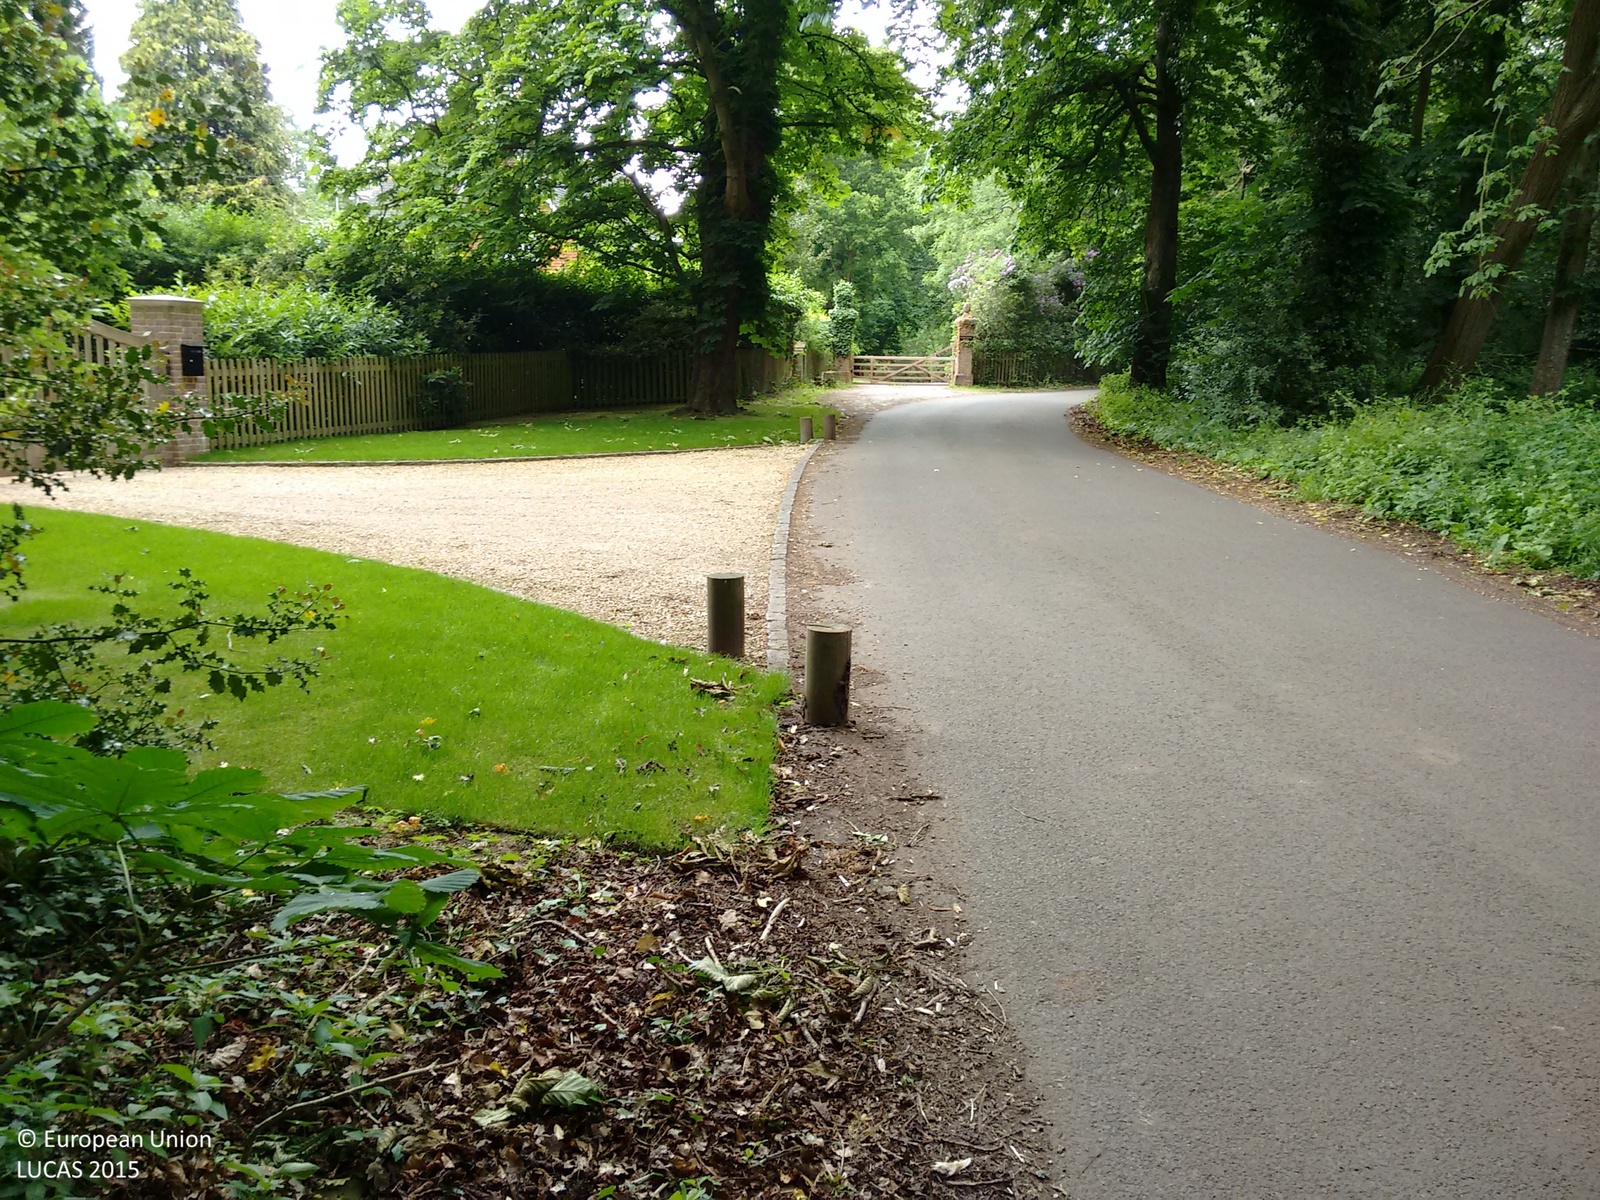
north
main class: Woodland
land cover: Broadleaved woodland
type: mesophytic deciduous forest
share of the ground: > 75 %
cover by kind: broadleaved forest trees 80 %, herbaceous plants 20 %
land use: Semi-natural and natural areas not in use
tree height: > 5 m
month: June
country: GB
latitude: 51.3890
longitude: -1.0384
